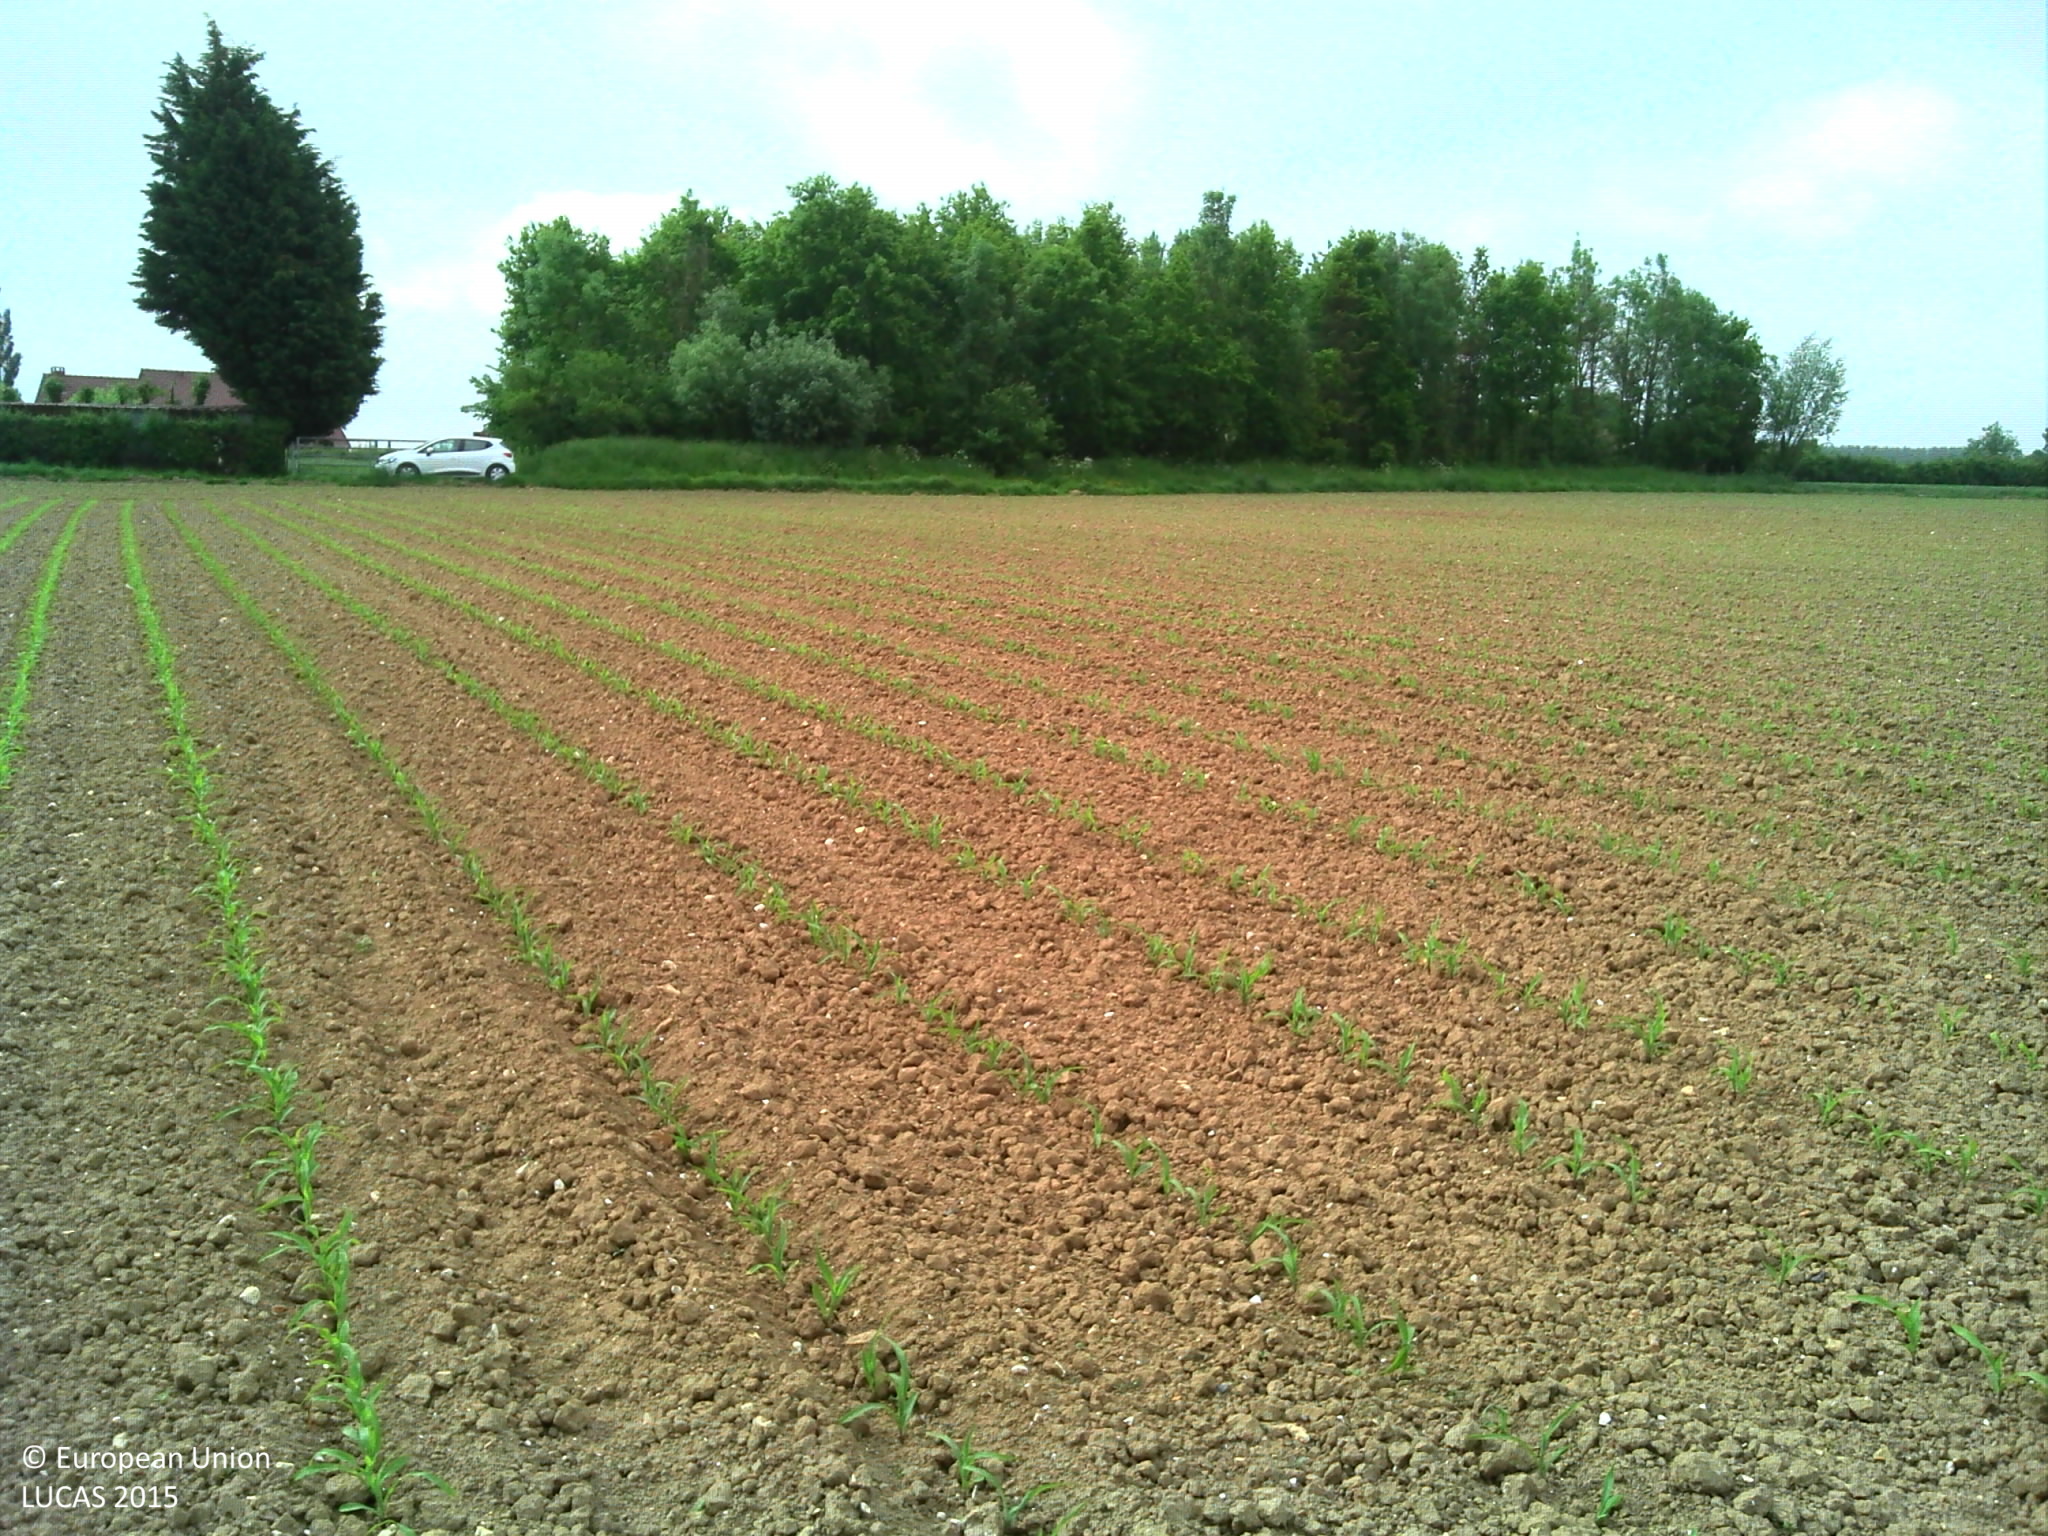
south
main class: Cropland
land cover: Maize
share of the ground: 10 - 25 %
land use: Agriculture (excluding fallow land and kitchen gardens)
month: May
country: FR
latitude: 50.6486
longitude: 2.3350
